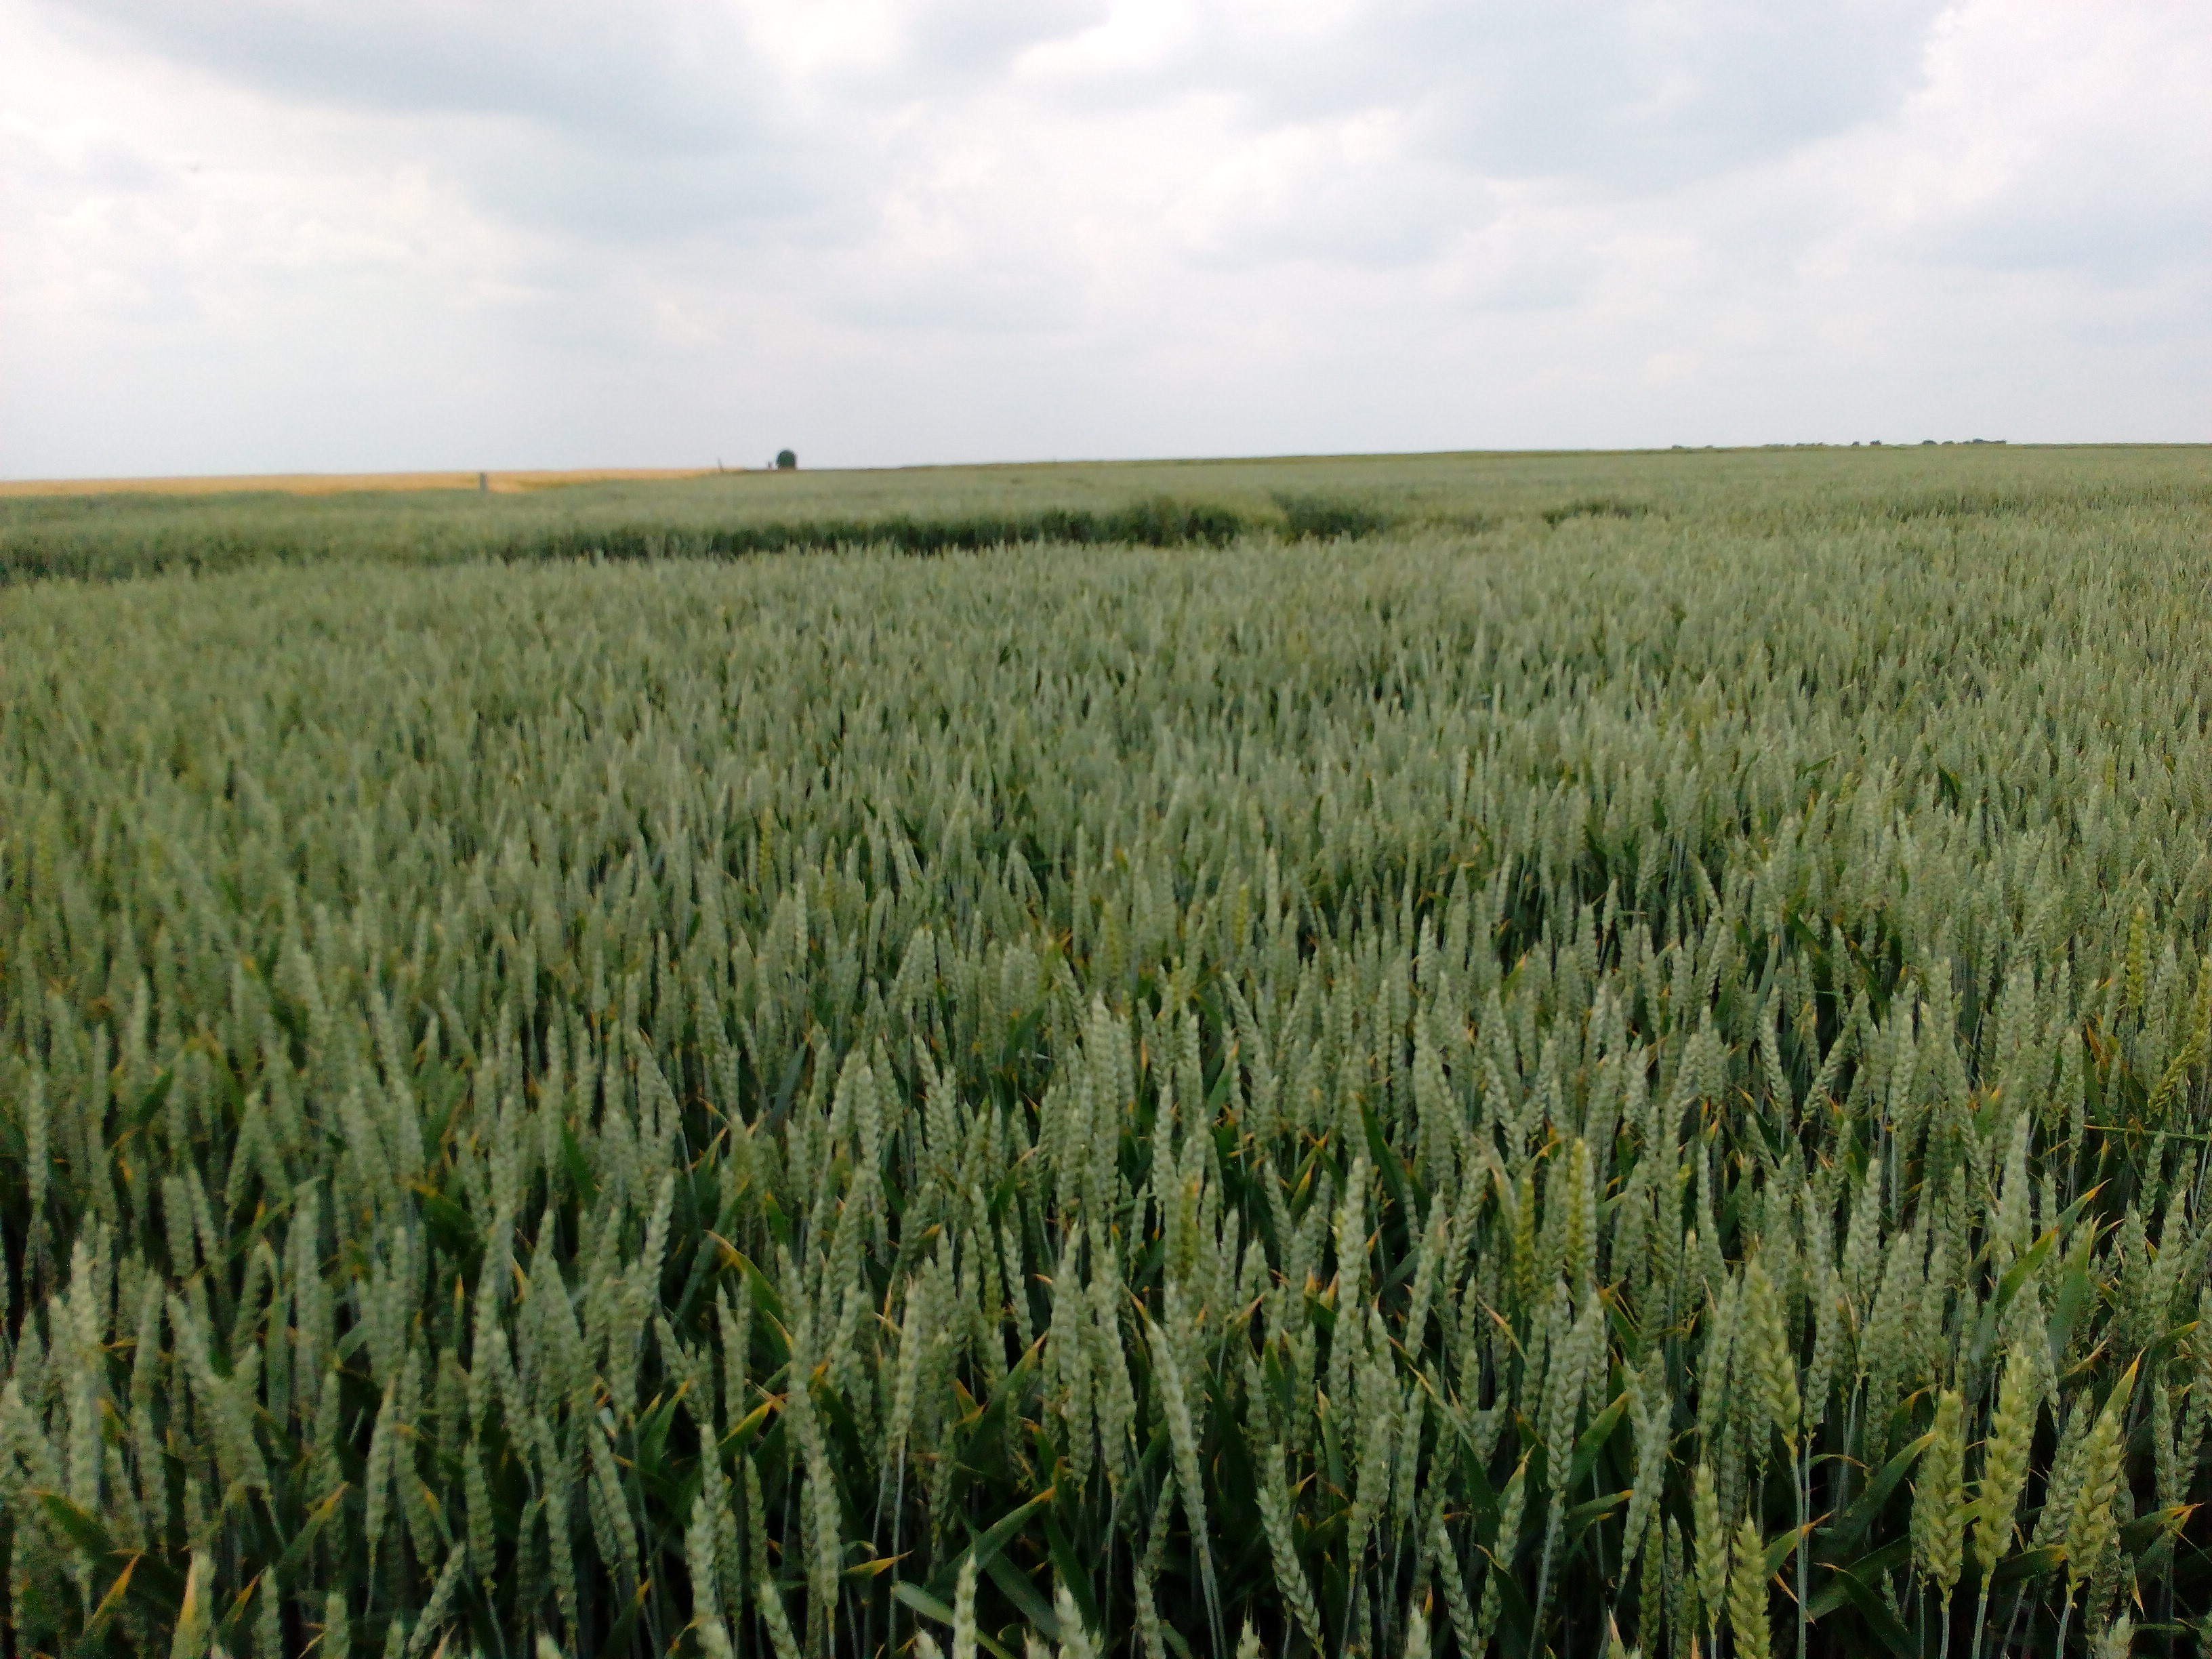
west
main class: Cropland
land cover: Common wheat
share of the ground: > 75 %
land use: Agriculture (excluding fallow land and kitchen gardens)
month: June
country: DE
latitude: 51.2398
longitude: 11.1026
